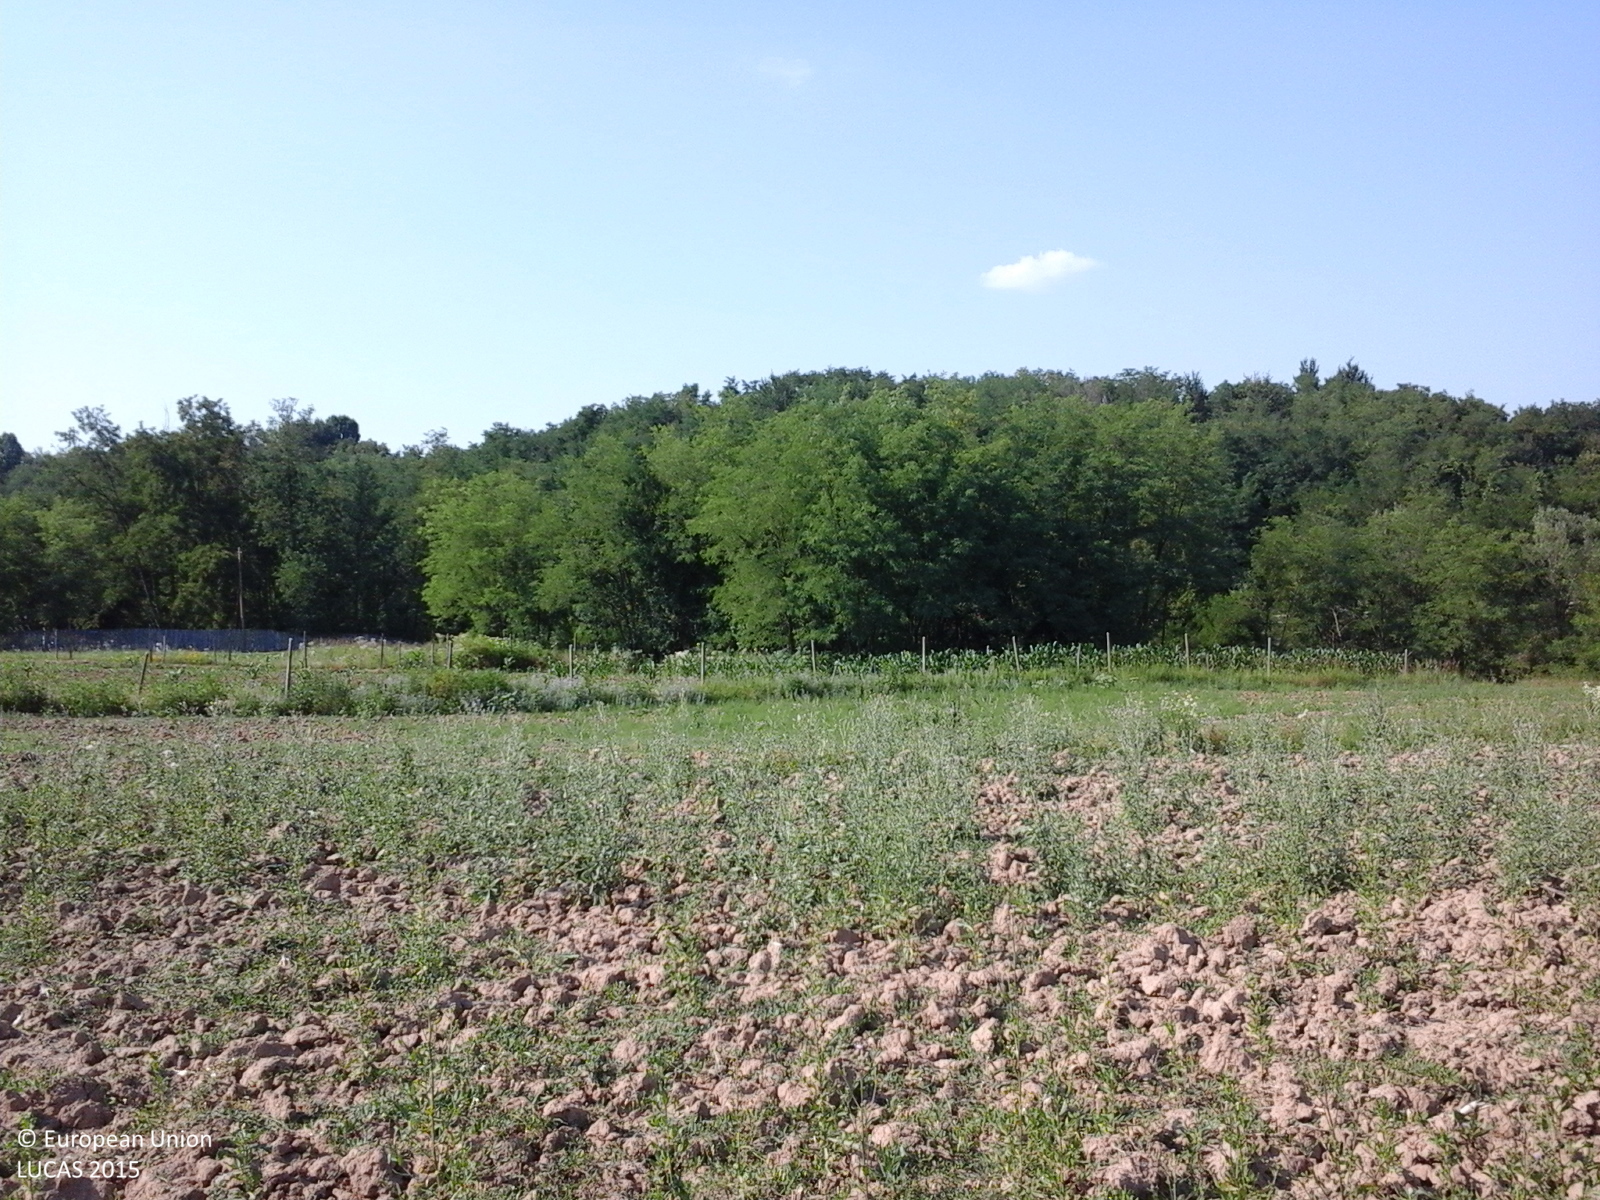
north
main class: Grassland
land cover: Spontaneously vegetated surfaces
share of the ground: 10 - 25 %
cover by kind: unconsolidated bare surface 85 %, herbaceous plants 15 %
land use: Agriculture (excluding fallow land and kitchen gardens)
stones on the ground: < 10 %
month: July
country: RO
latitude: 44.6952
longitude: 24.6509
